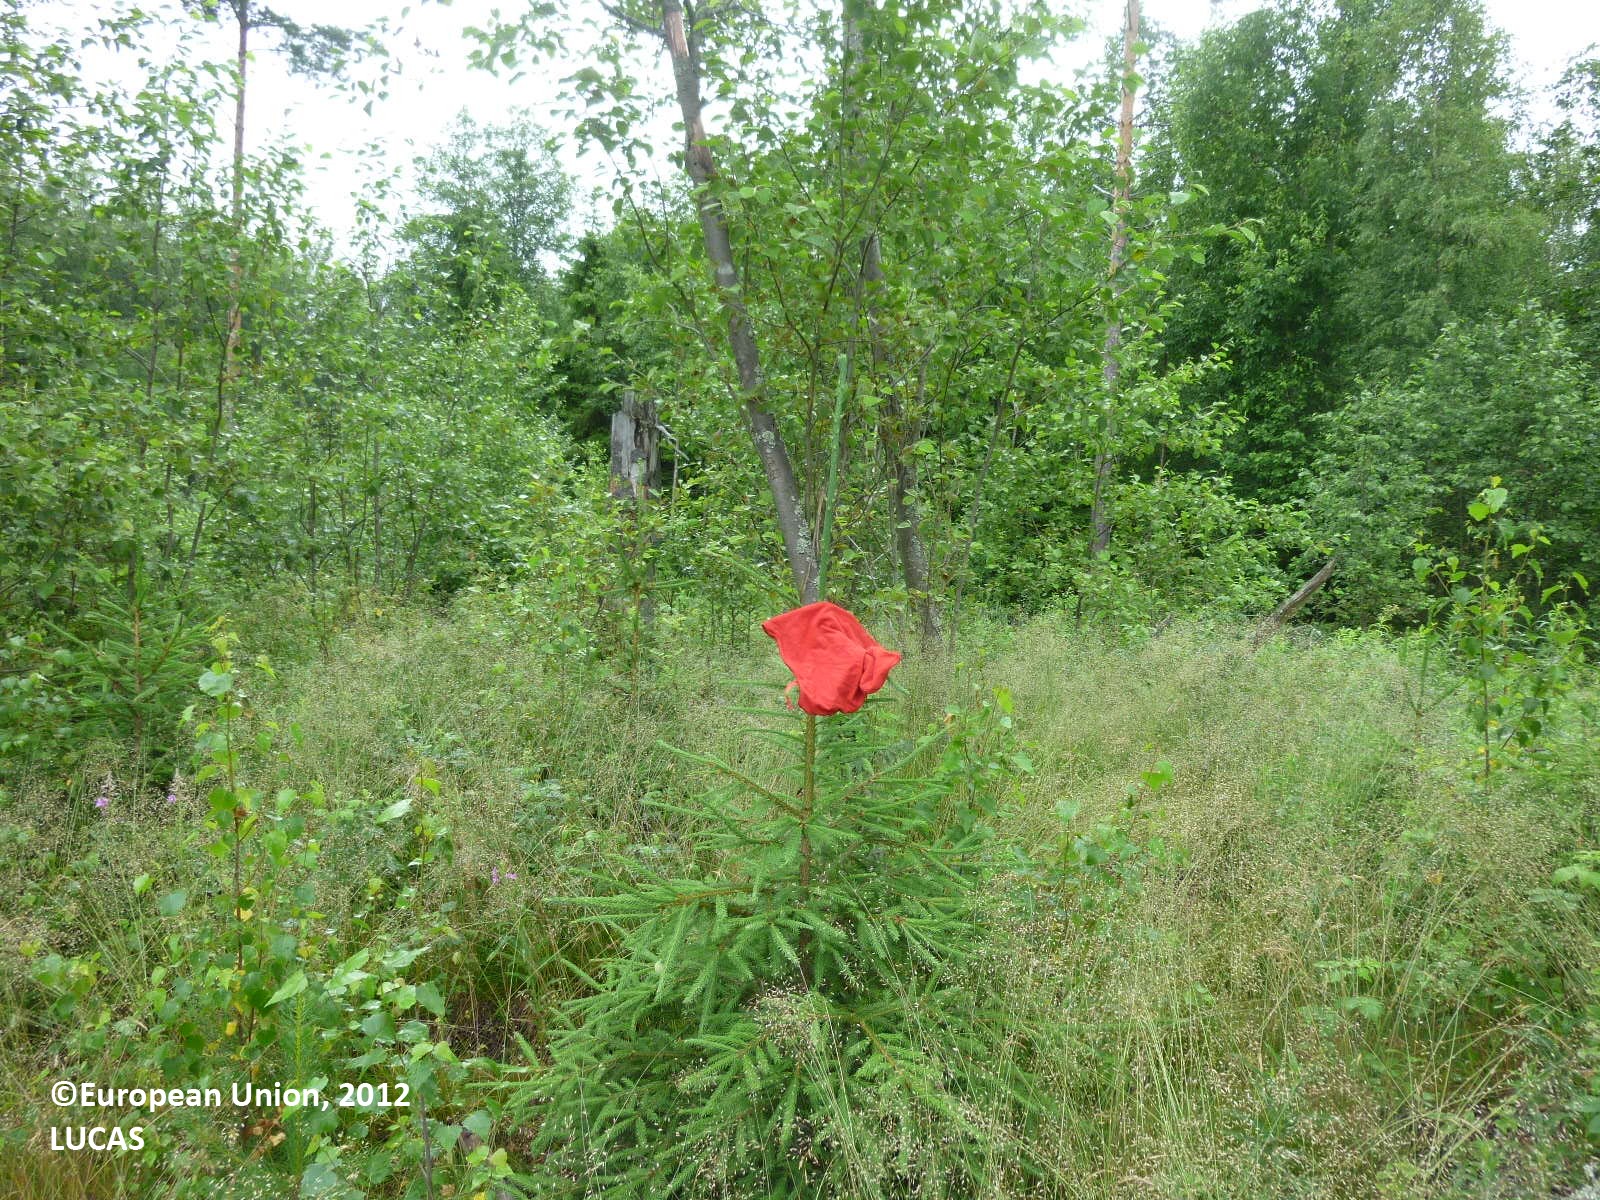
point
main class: Woodland
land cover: Broadleaved woodland
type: boreal forest
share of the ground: > 75 %
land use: Forestry
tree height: > 5 m
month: July
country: FI
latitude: 61.4741
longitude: 22.2044
